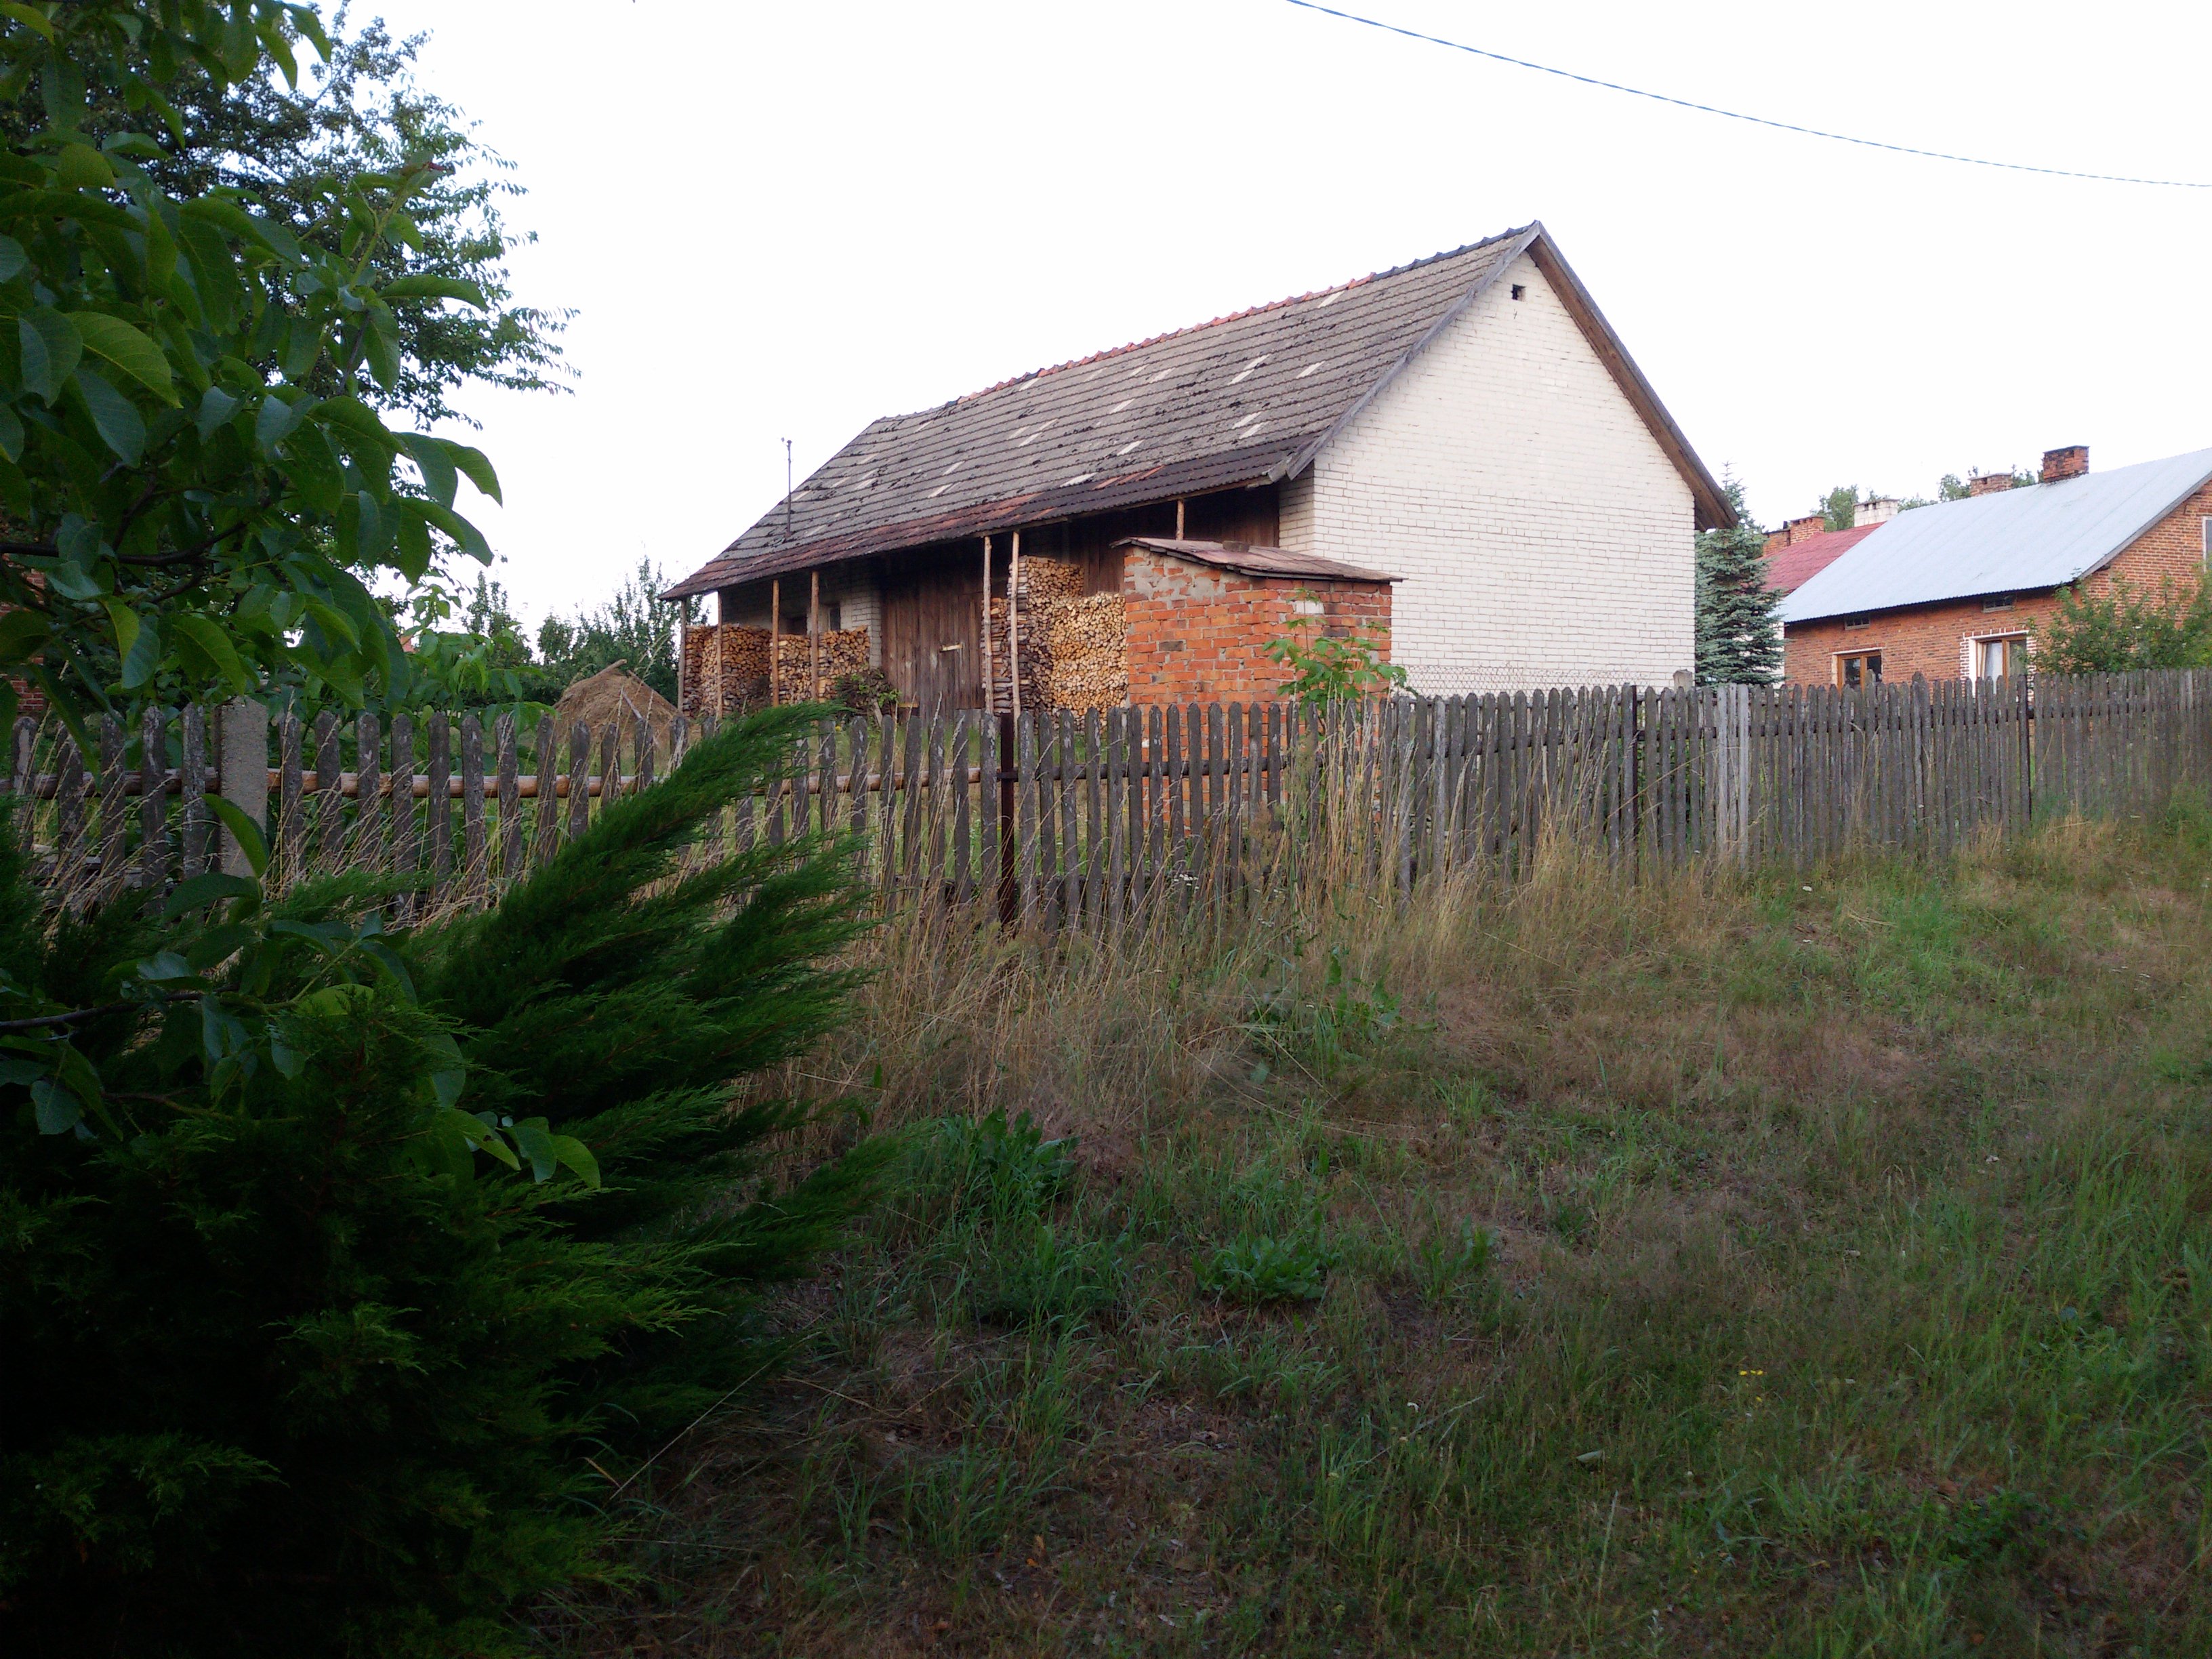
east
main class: Grassland
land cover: Grassland with sparse tree/shrub cover
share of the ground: 50 - 75 %
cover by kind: herbaceous plants 95 %, coniferous forest trees 5 %
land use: Residential
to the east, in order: Grassland with sparse tree/shrub cover; Artificial constructions in urban areas; Broadleaved woodland; Spontaneously vegetated surfaces; Tracks; Broadleaved woodland
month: July
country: PL
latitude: 50.2158
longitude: 22.3820
